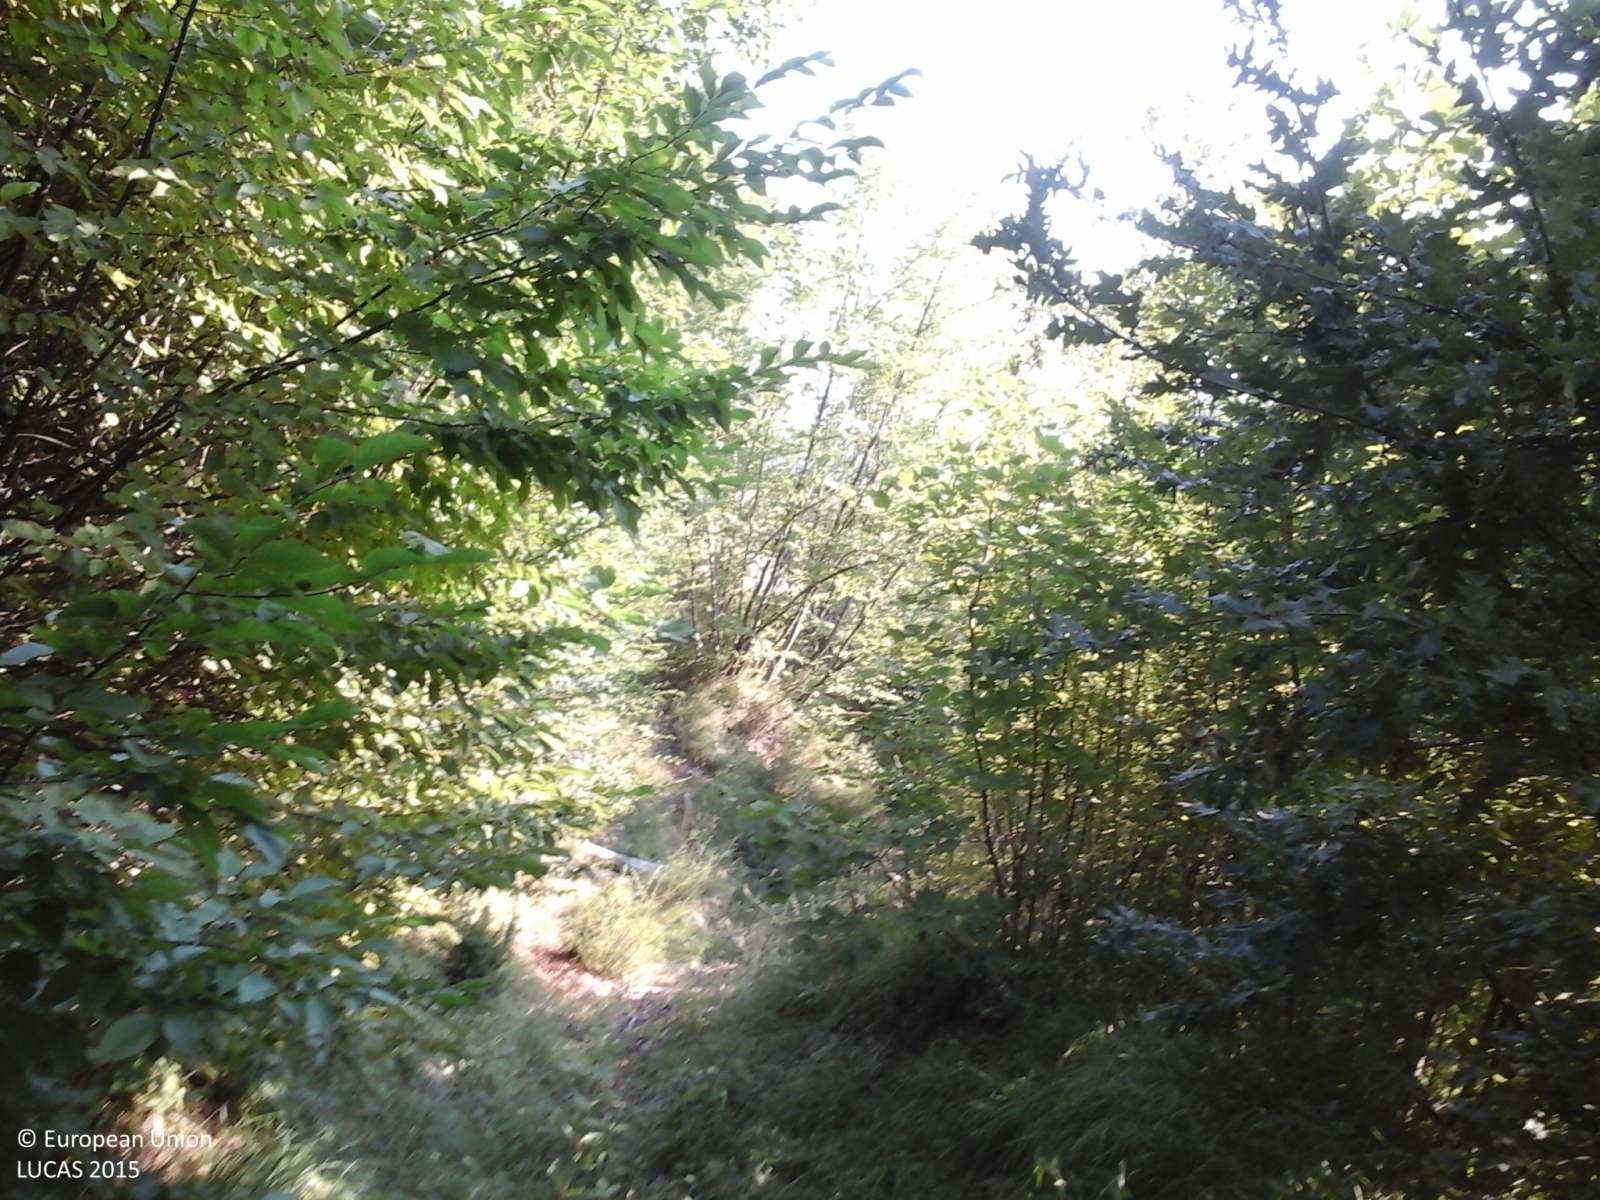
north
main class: Woodland
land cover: Broadleaved woodland
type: thermophilous deciduous forest
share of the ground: > 75 %
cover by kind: broadleaved forest trees 100 %
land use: Forestry
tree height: > 5 m
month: August
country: IT
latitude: 43.7494
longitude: 12.2174
